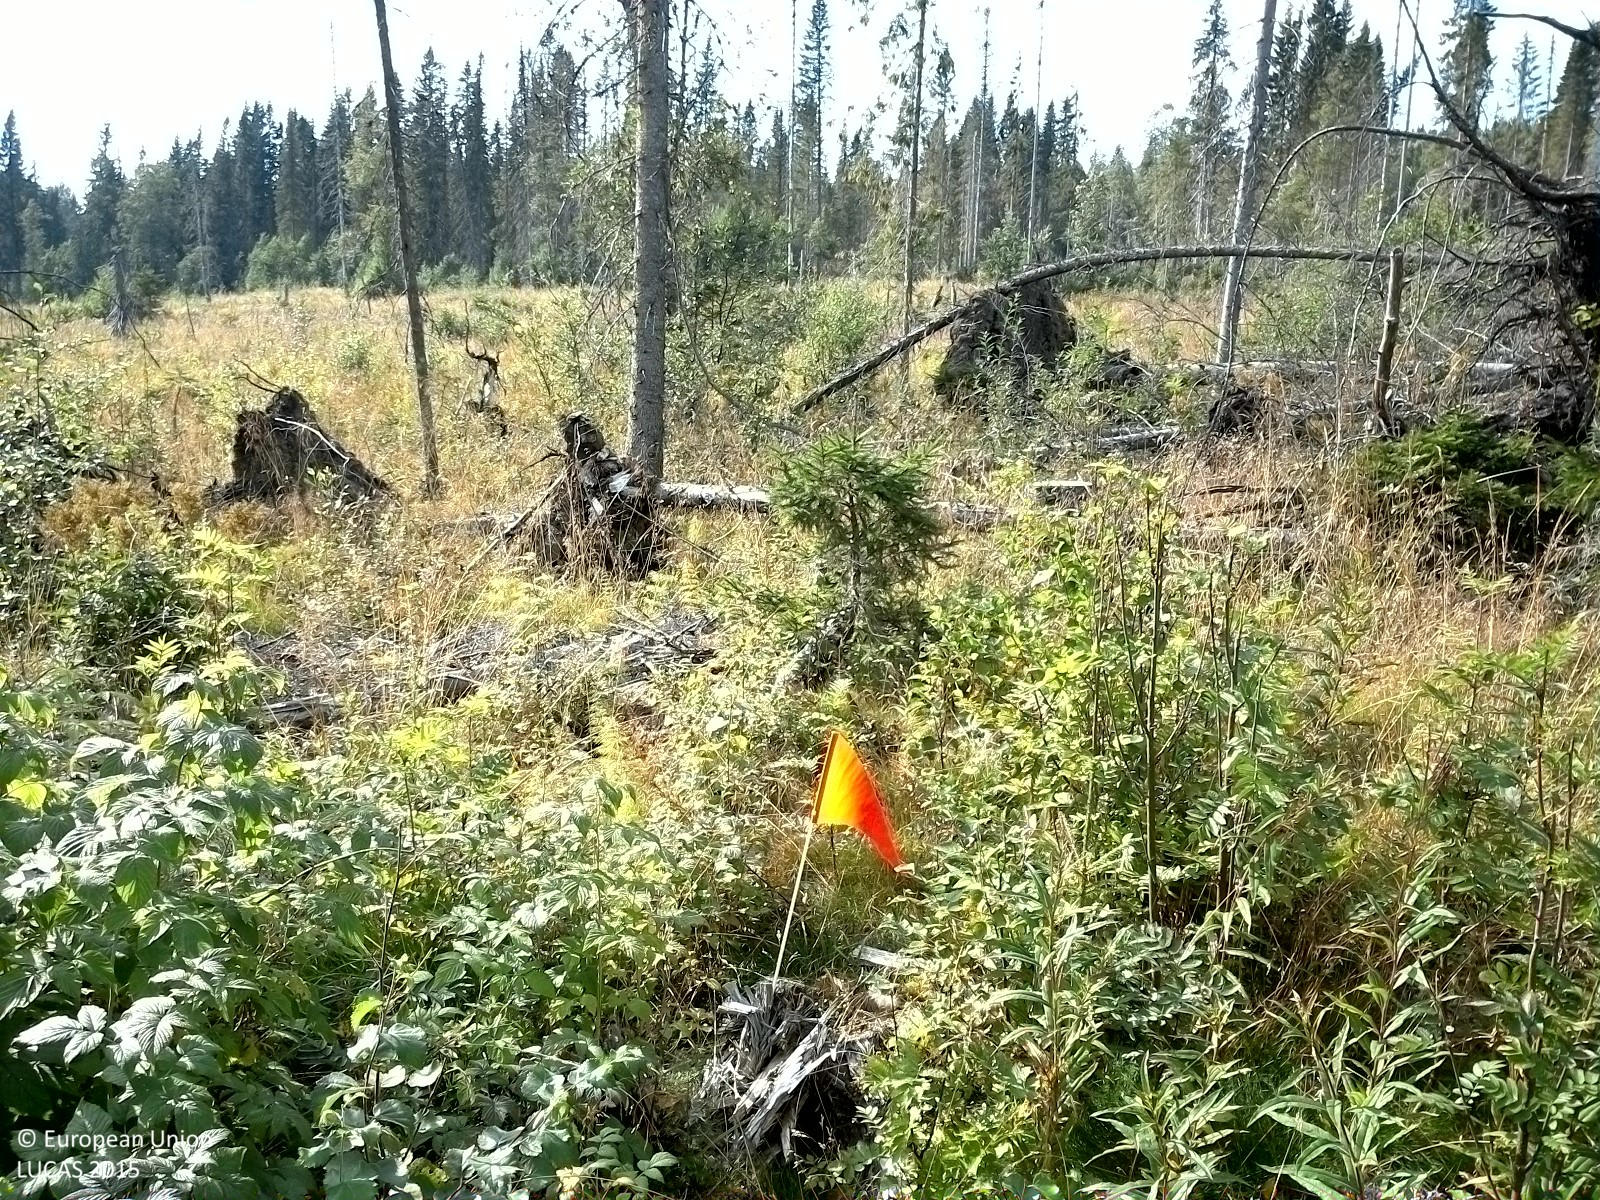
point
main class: Woodland
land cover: Spruce dominated mixed woodland
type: boreal forest
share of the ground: 25 - 50 %
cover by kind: herbaceous plants 55 %, broadleaved forest trees 20 %, coniferous forest trees 10 %, shrubs 5 %
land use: Forestry
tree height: > 5 m
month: August
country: SE
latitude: 62.4126
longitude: 16.1929
